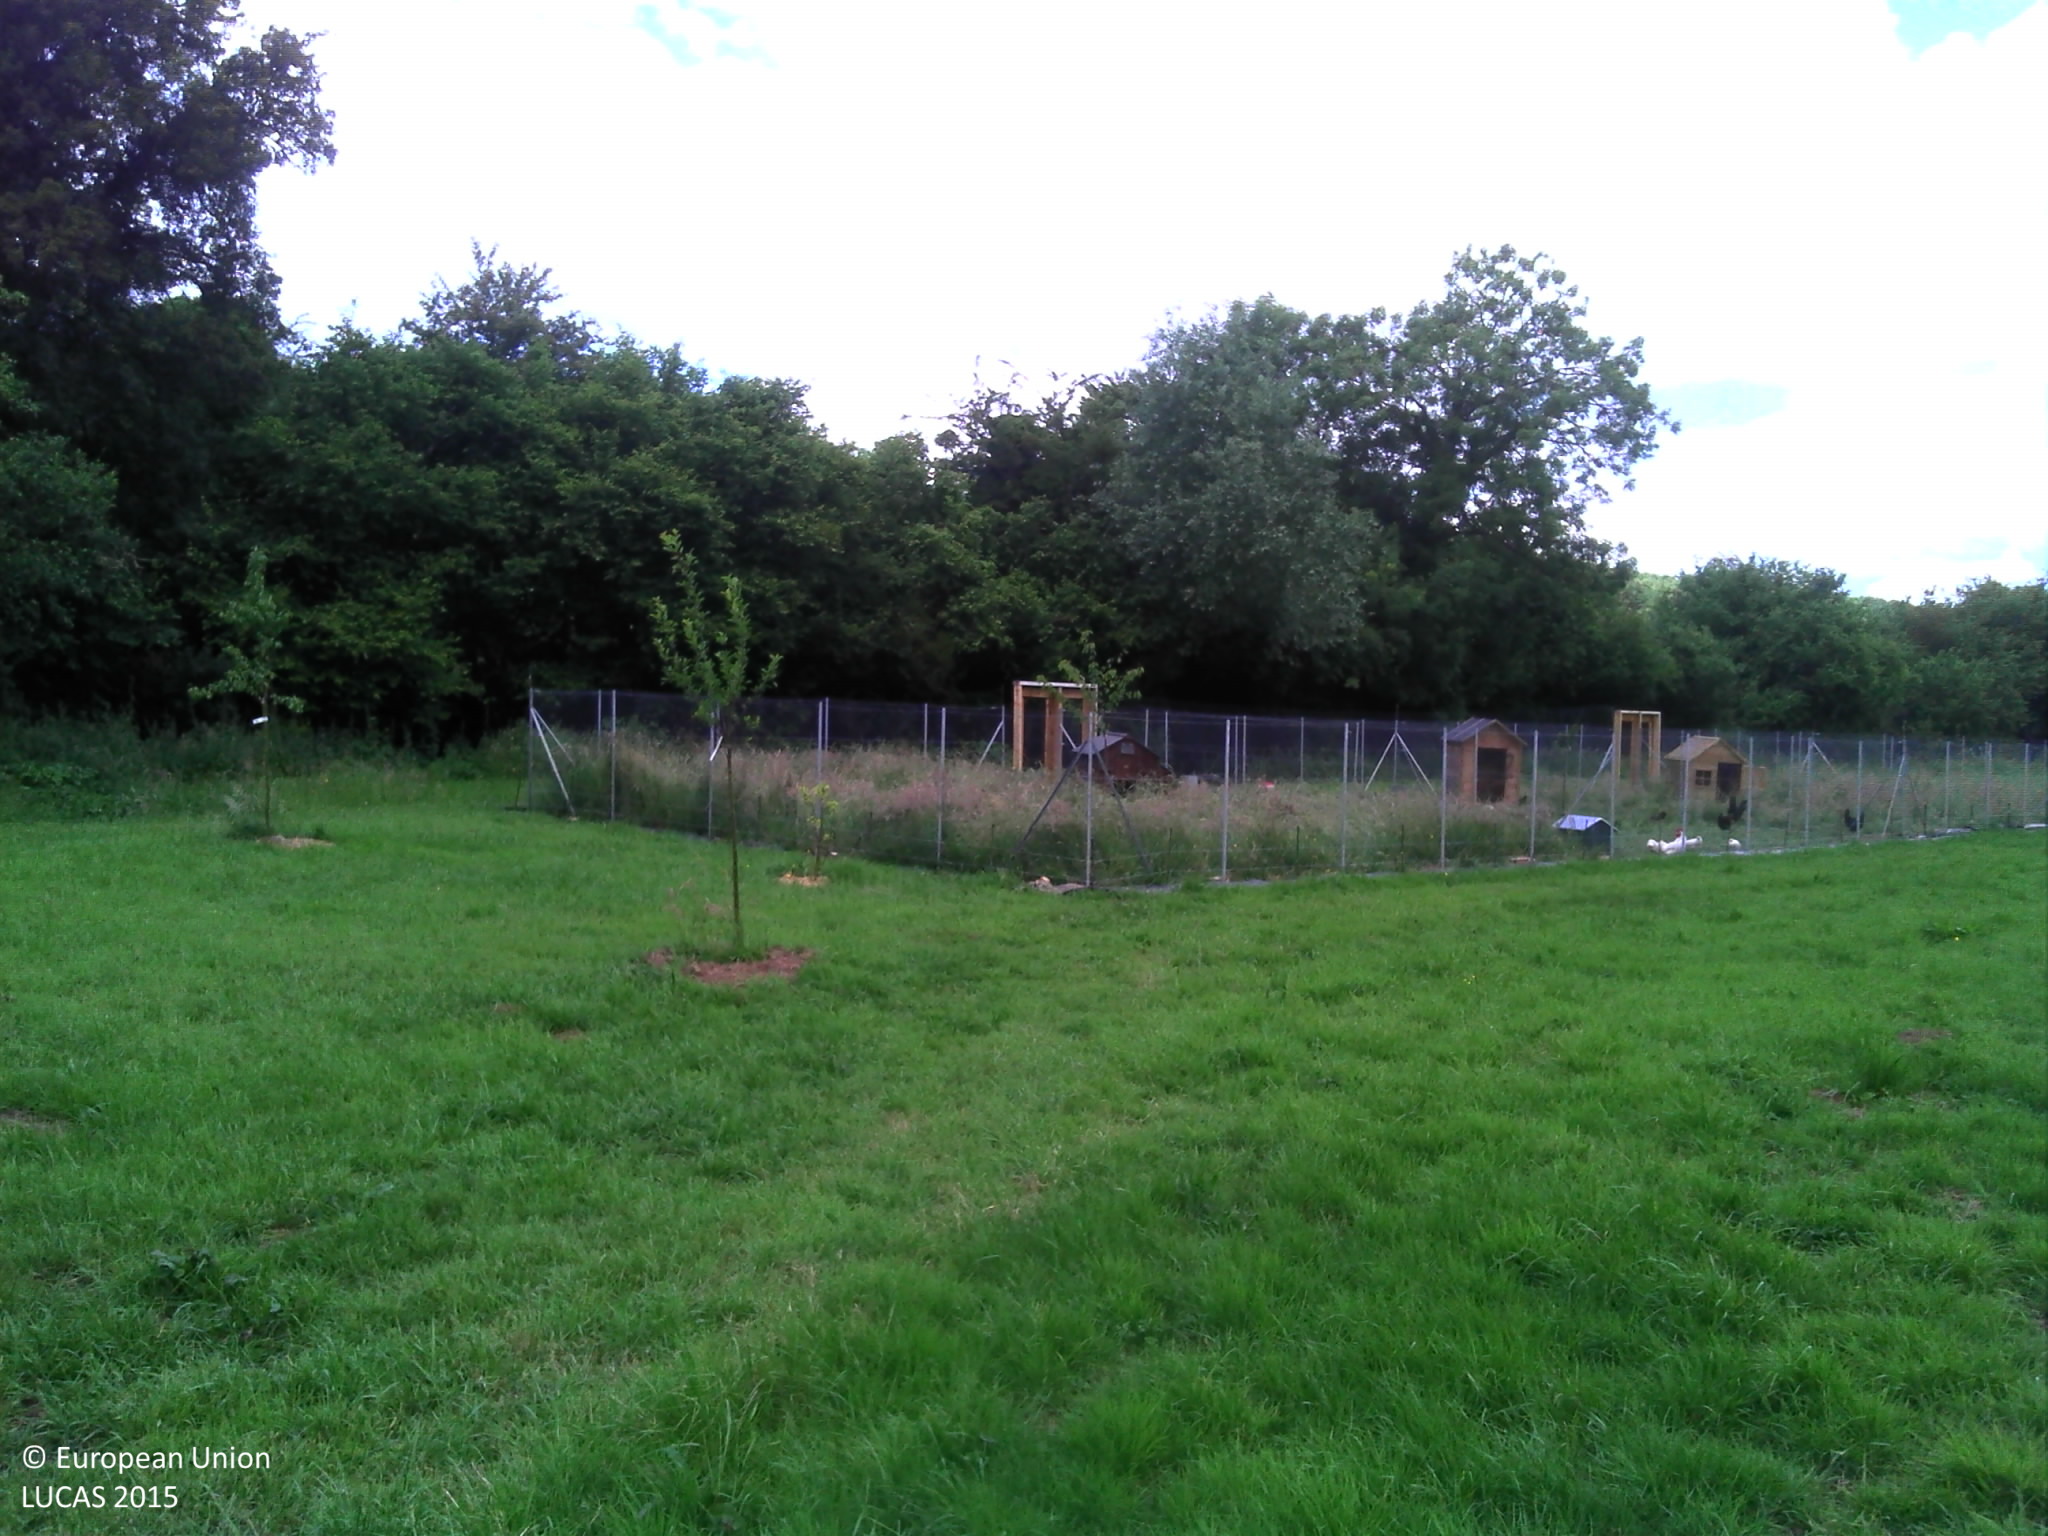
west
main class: Grassland
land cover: Grassland without tree/shrub cover
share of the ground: > 75 %
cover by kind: herbaceous plants 100 %
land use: Agriculture (excluding fallow land and kitchen gardens)
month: June
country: FR
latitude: 48.9832
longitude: 0.4221
